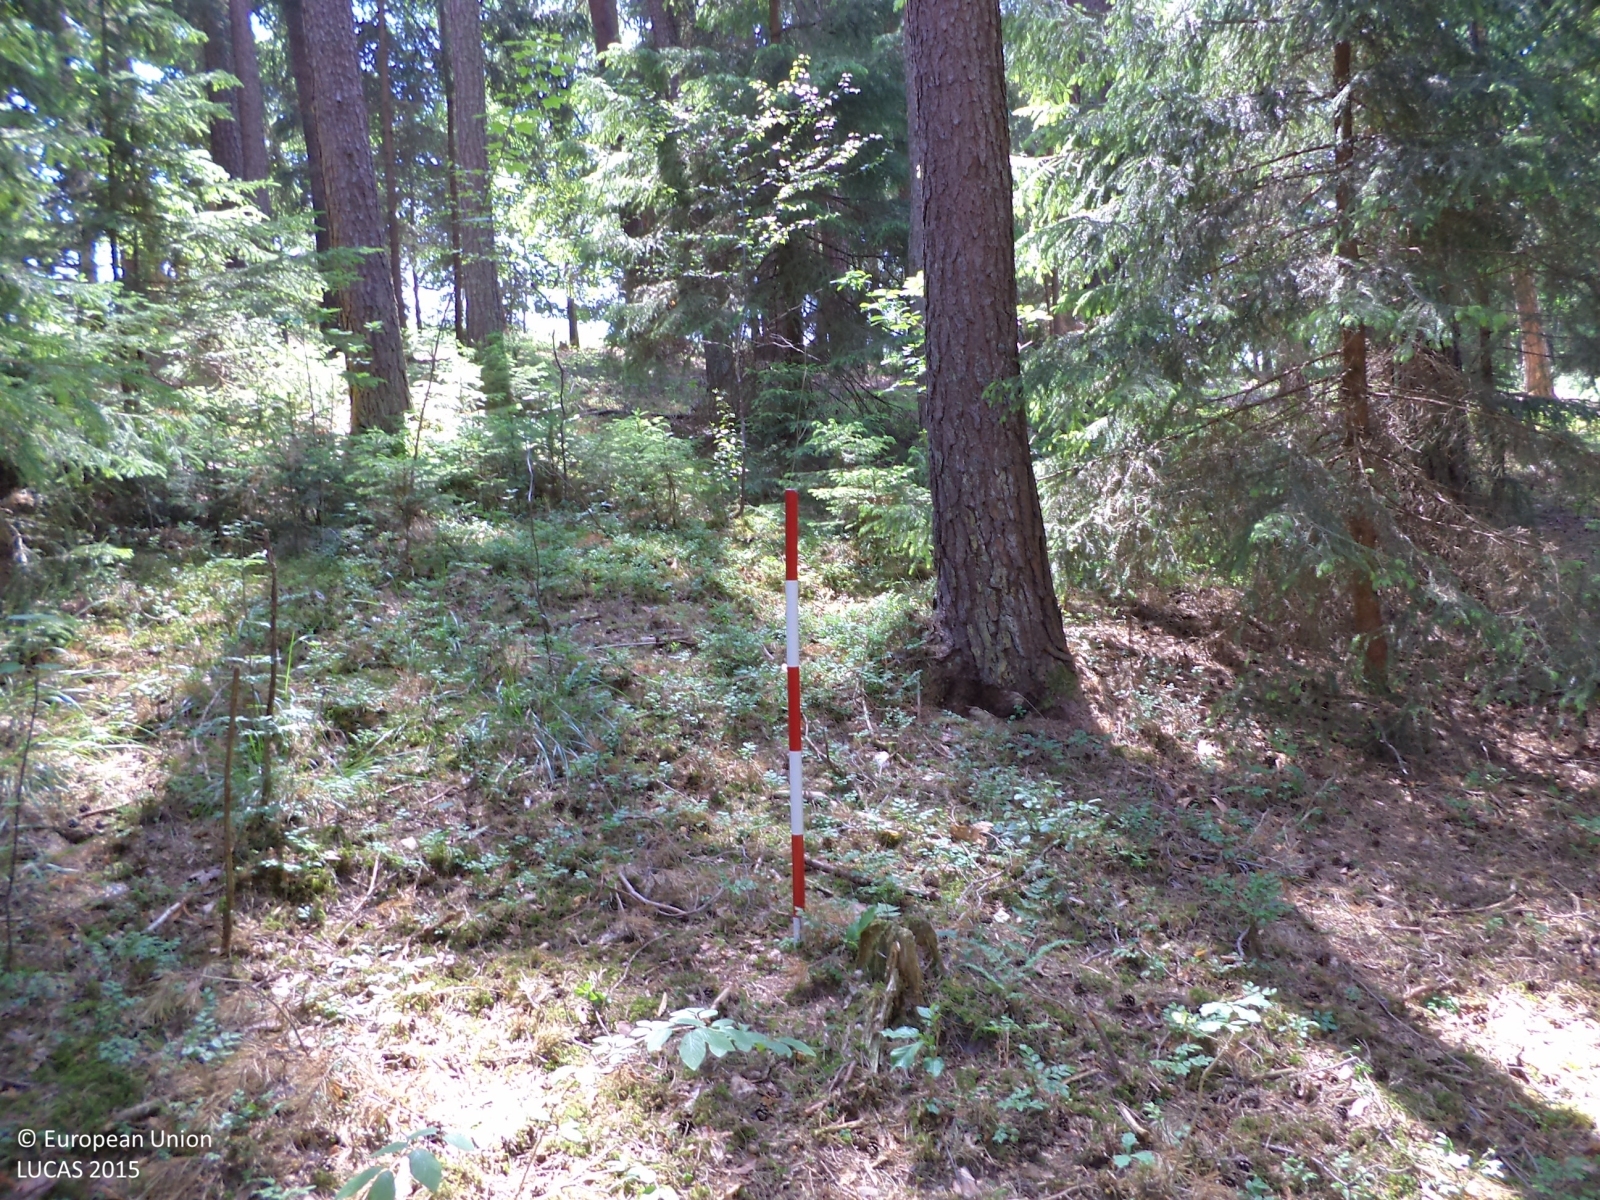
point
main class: Woodland
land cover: Other coniferous woodland
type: hemiboreal forest and nemoral coniferous forest and mixed broadleaved-coniferous forest
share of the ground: > 75 %
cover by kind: coniferous forest trees 75 %, broadleaved forest trees 20 %, herbaceous plants 5 %
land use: Forestry
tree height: > 5 m
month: June
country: CZ
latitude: 49.3737
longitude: 14.5326
